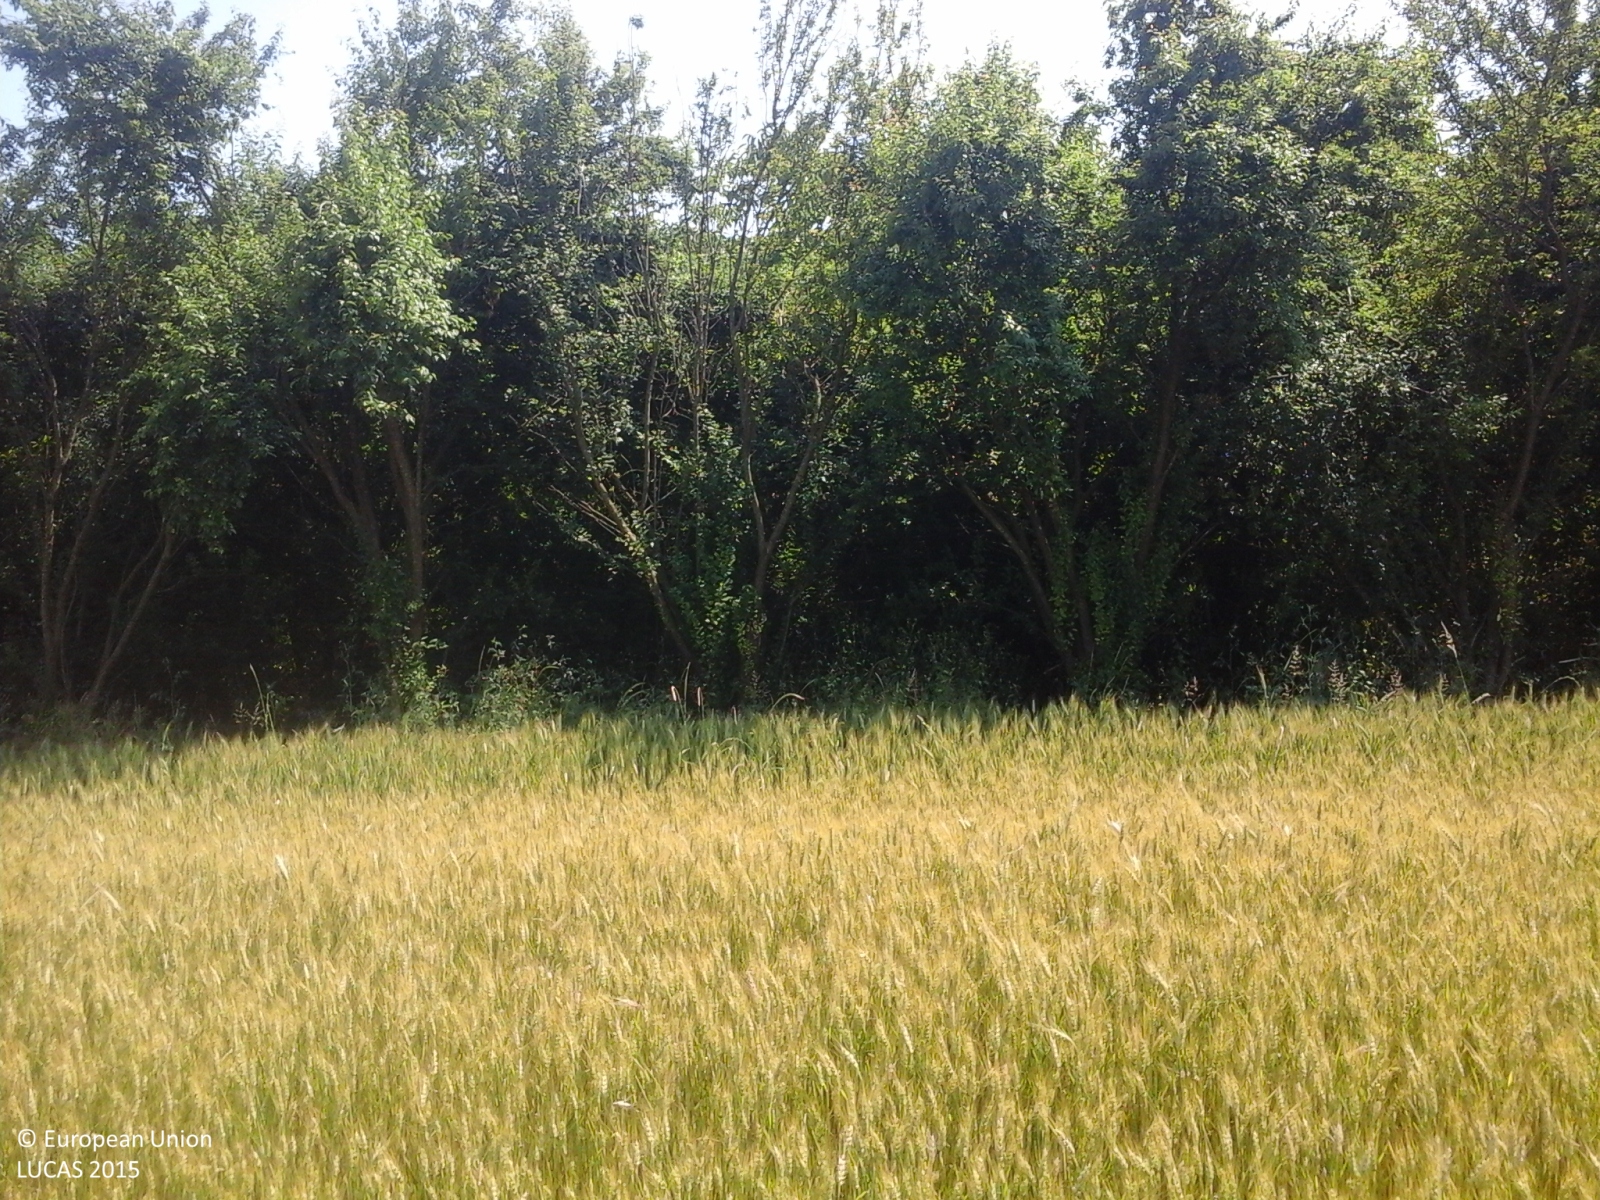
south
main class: Cropland
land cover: Common wheat
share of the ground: > 75 %
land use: Agriculture (excluding fallow land and kitchen gardens)
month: June
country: IT
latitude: 44.9456
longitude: 10.0380
